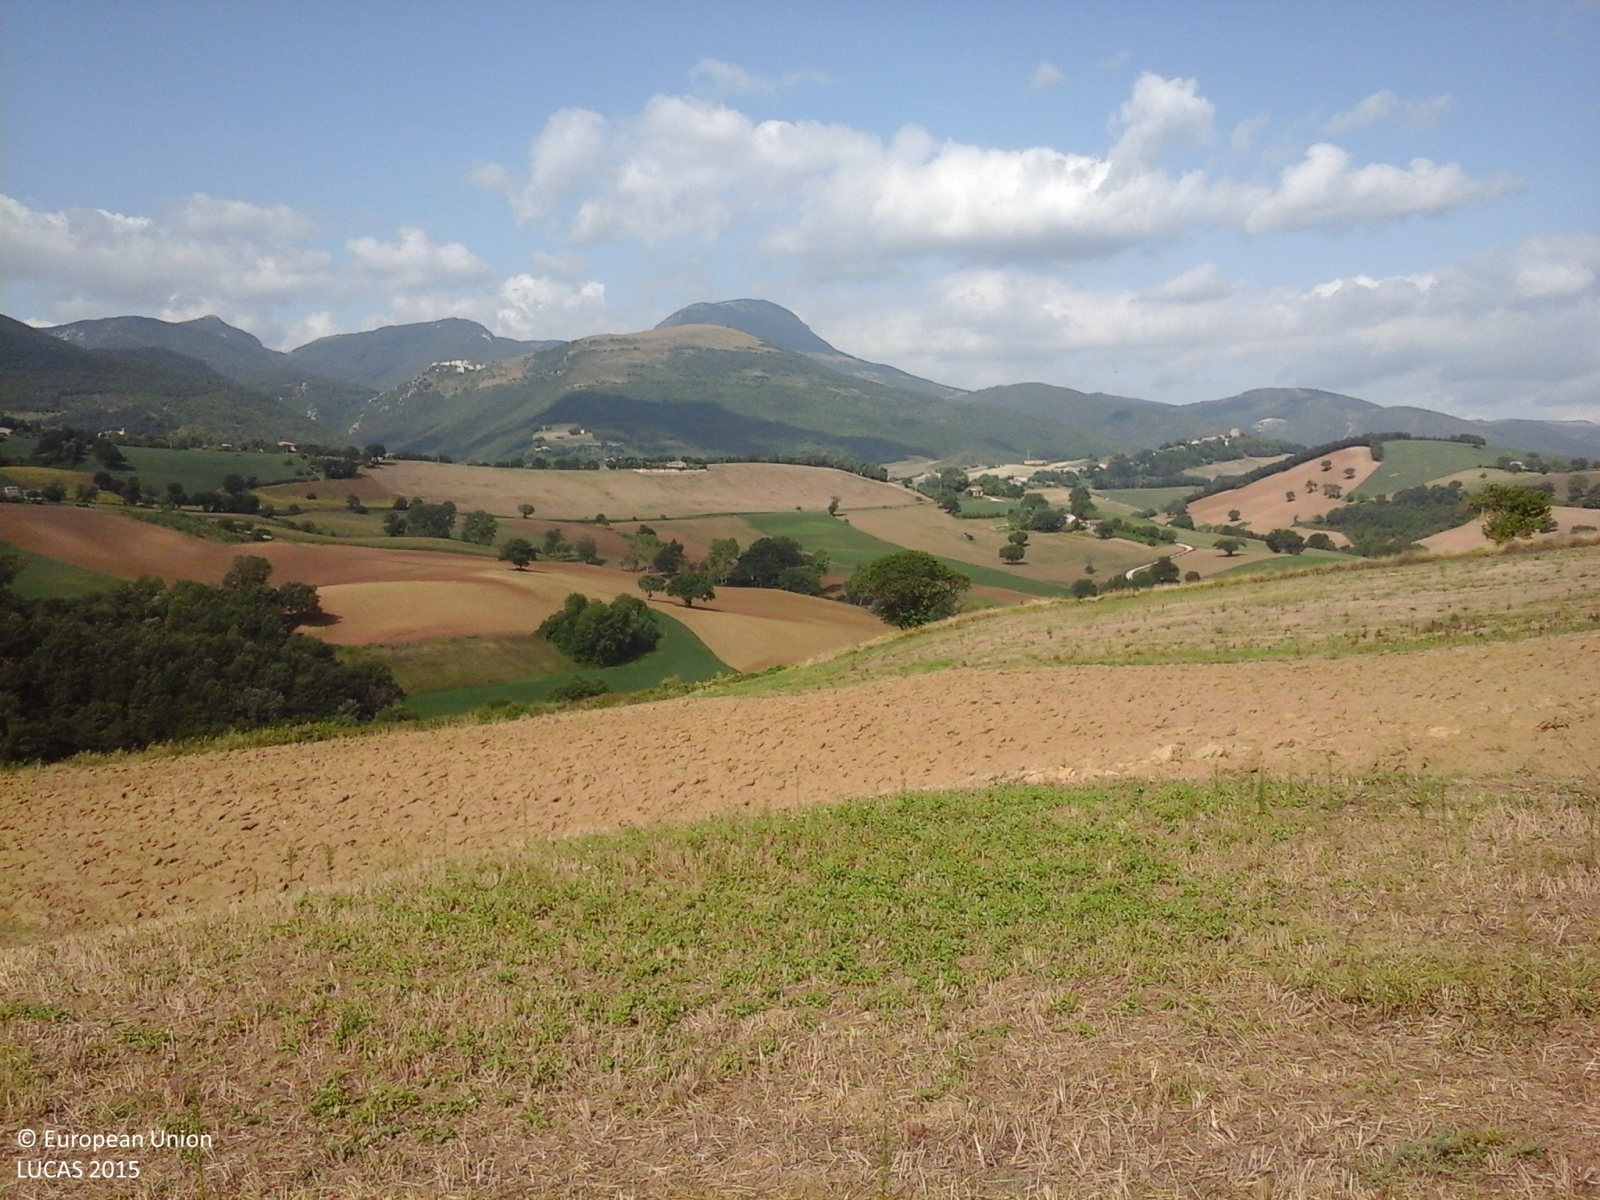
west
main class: Cropland
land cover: Durum wheat
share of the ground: < 10 %
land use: Agriculture (excluding fallow land and kitchen gardens)
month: August
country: IT
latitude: 43.3274
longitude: 13.1612
